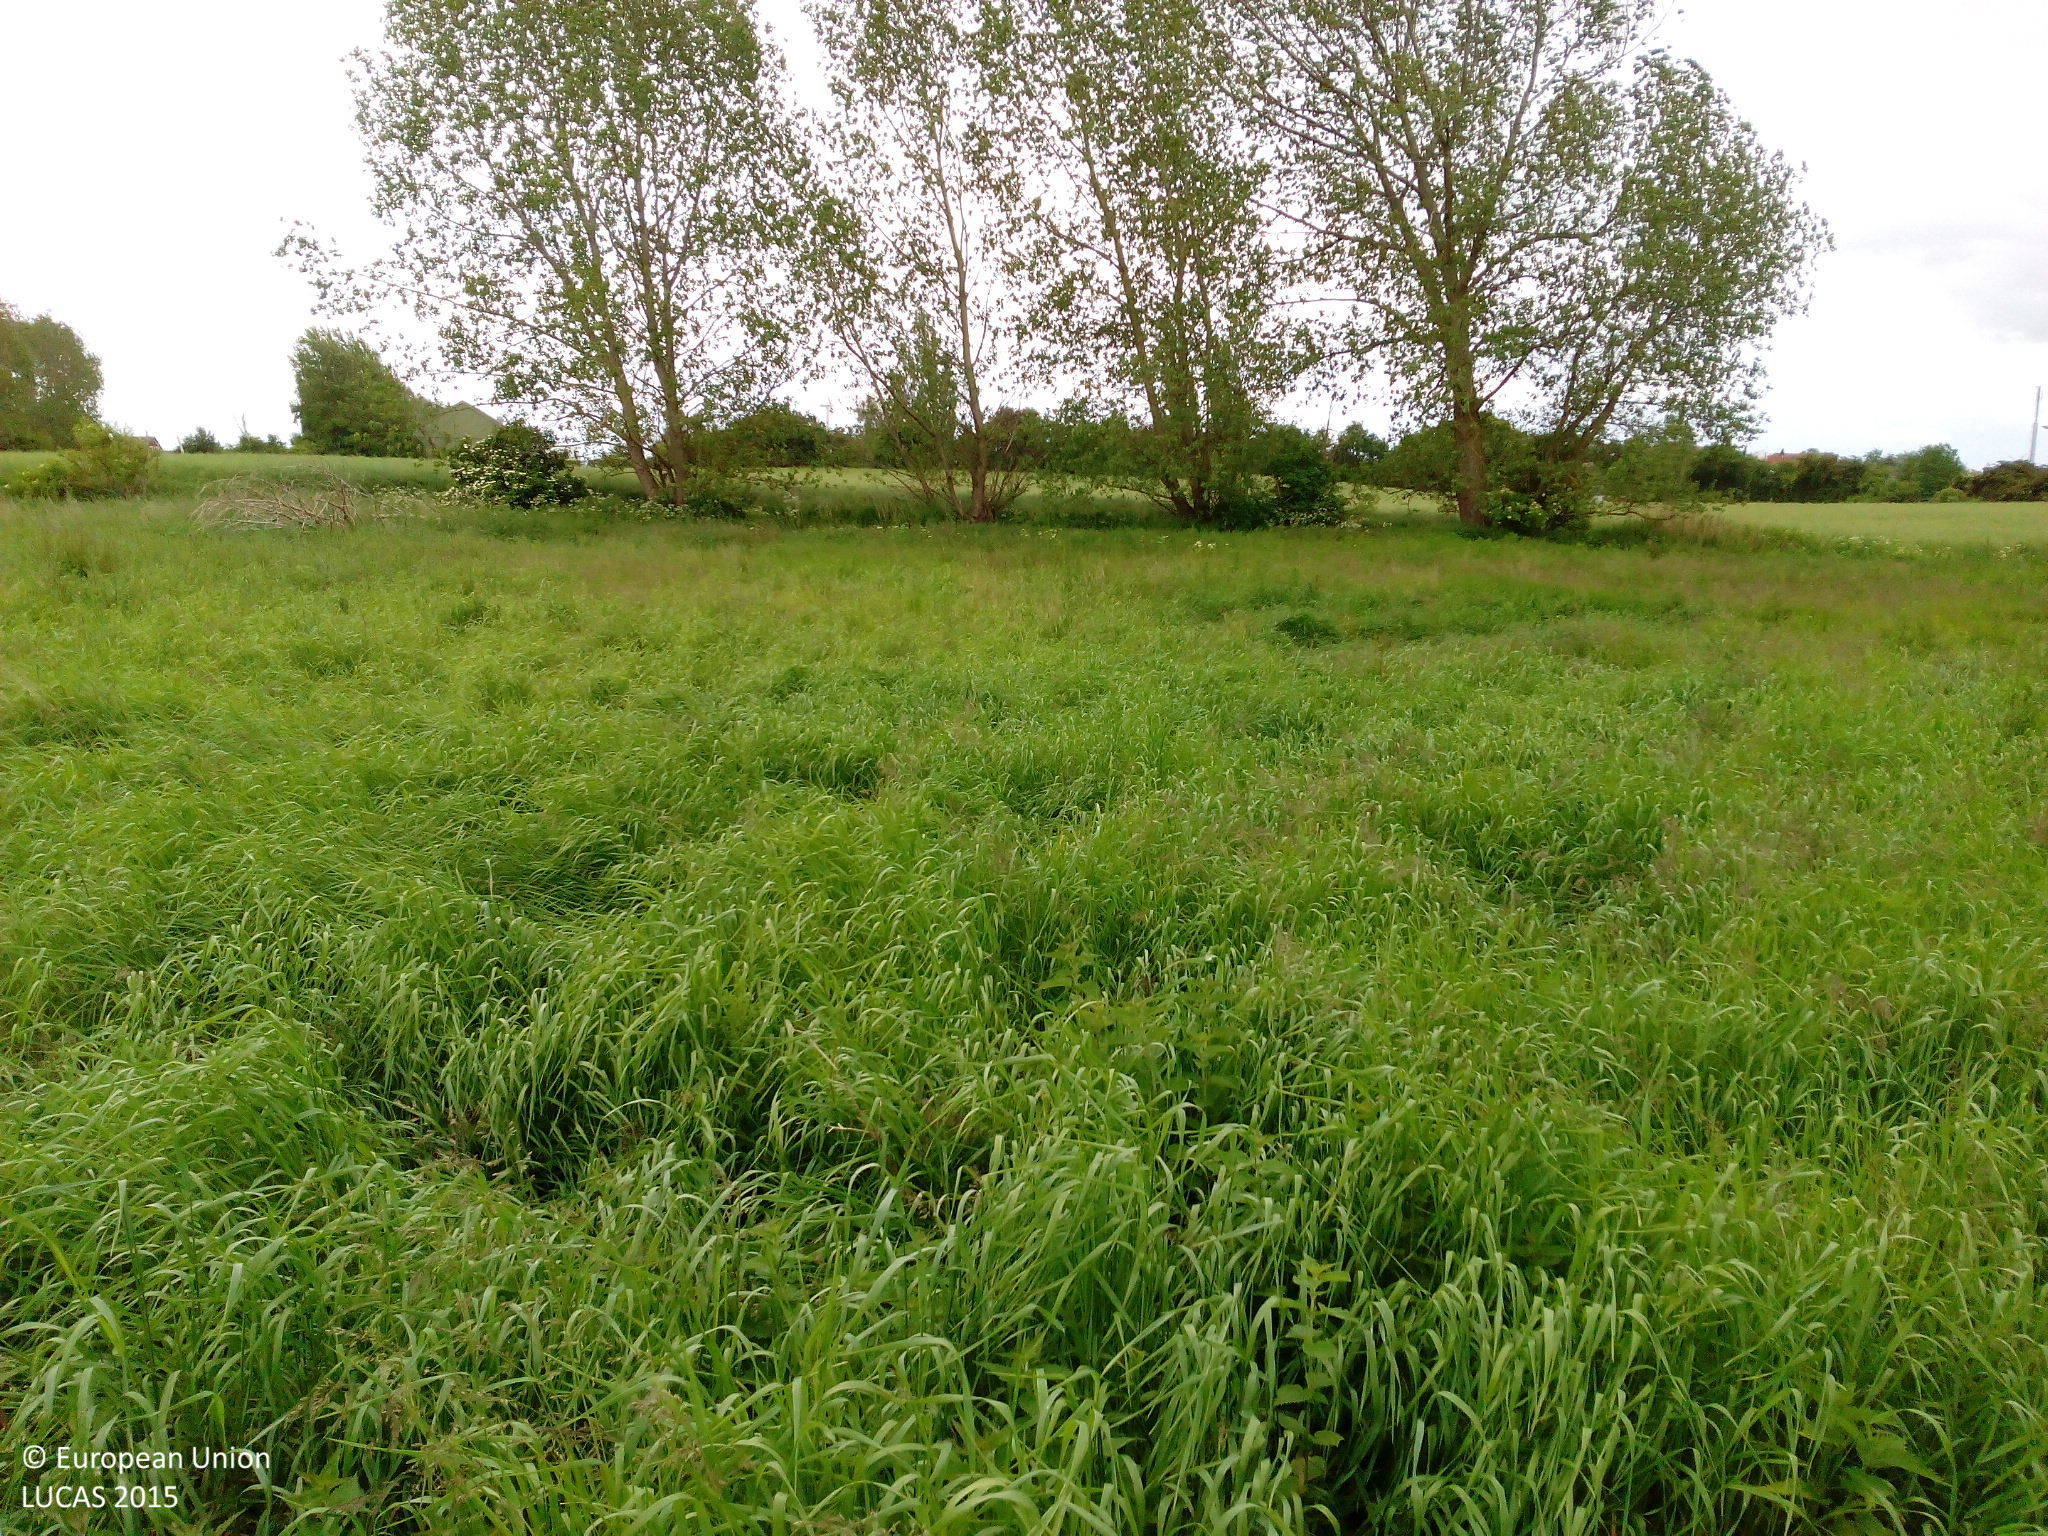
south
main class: Grassland
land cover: Spontaneously vegetated surfaces
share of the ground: > 75 %
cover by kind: herbaceous plants 100 %
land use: Semi-natural and natural areas not in use
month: June
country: DK
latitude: 54.9454
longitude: 10.7332
